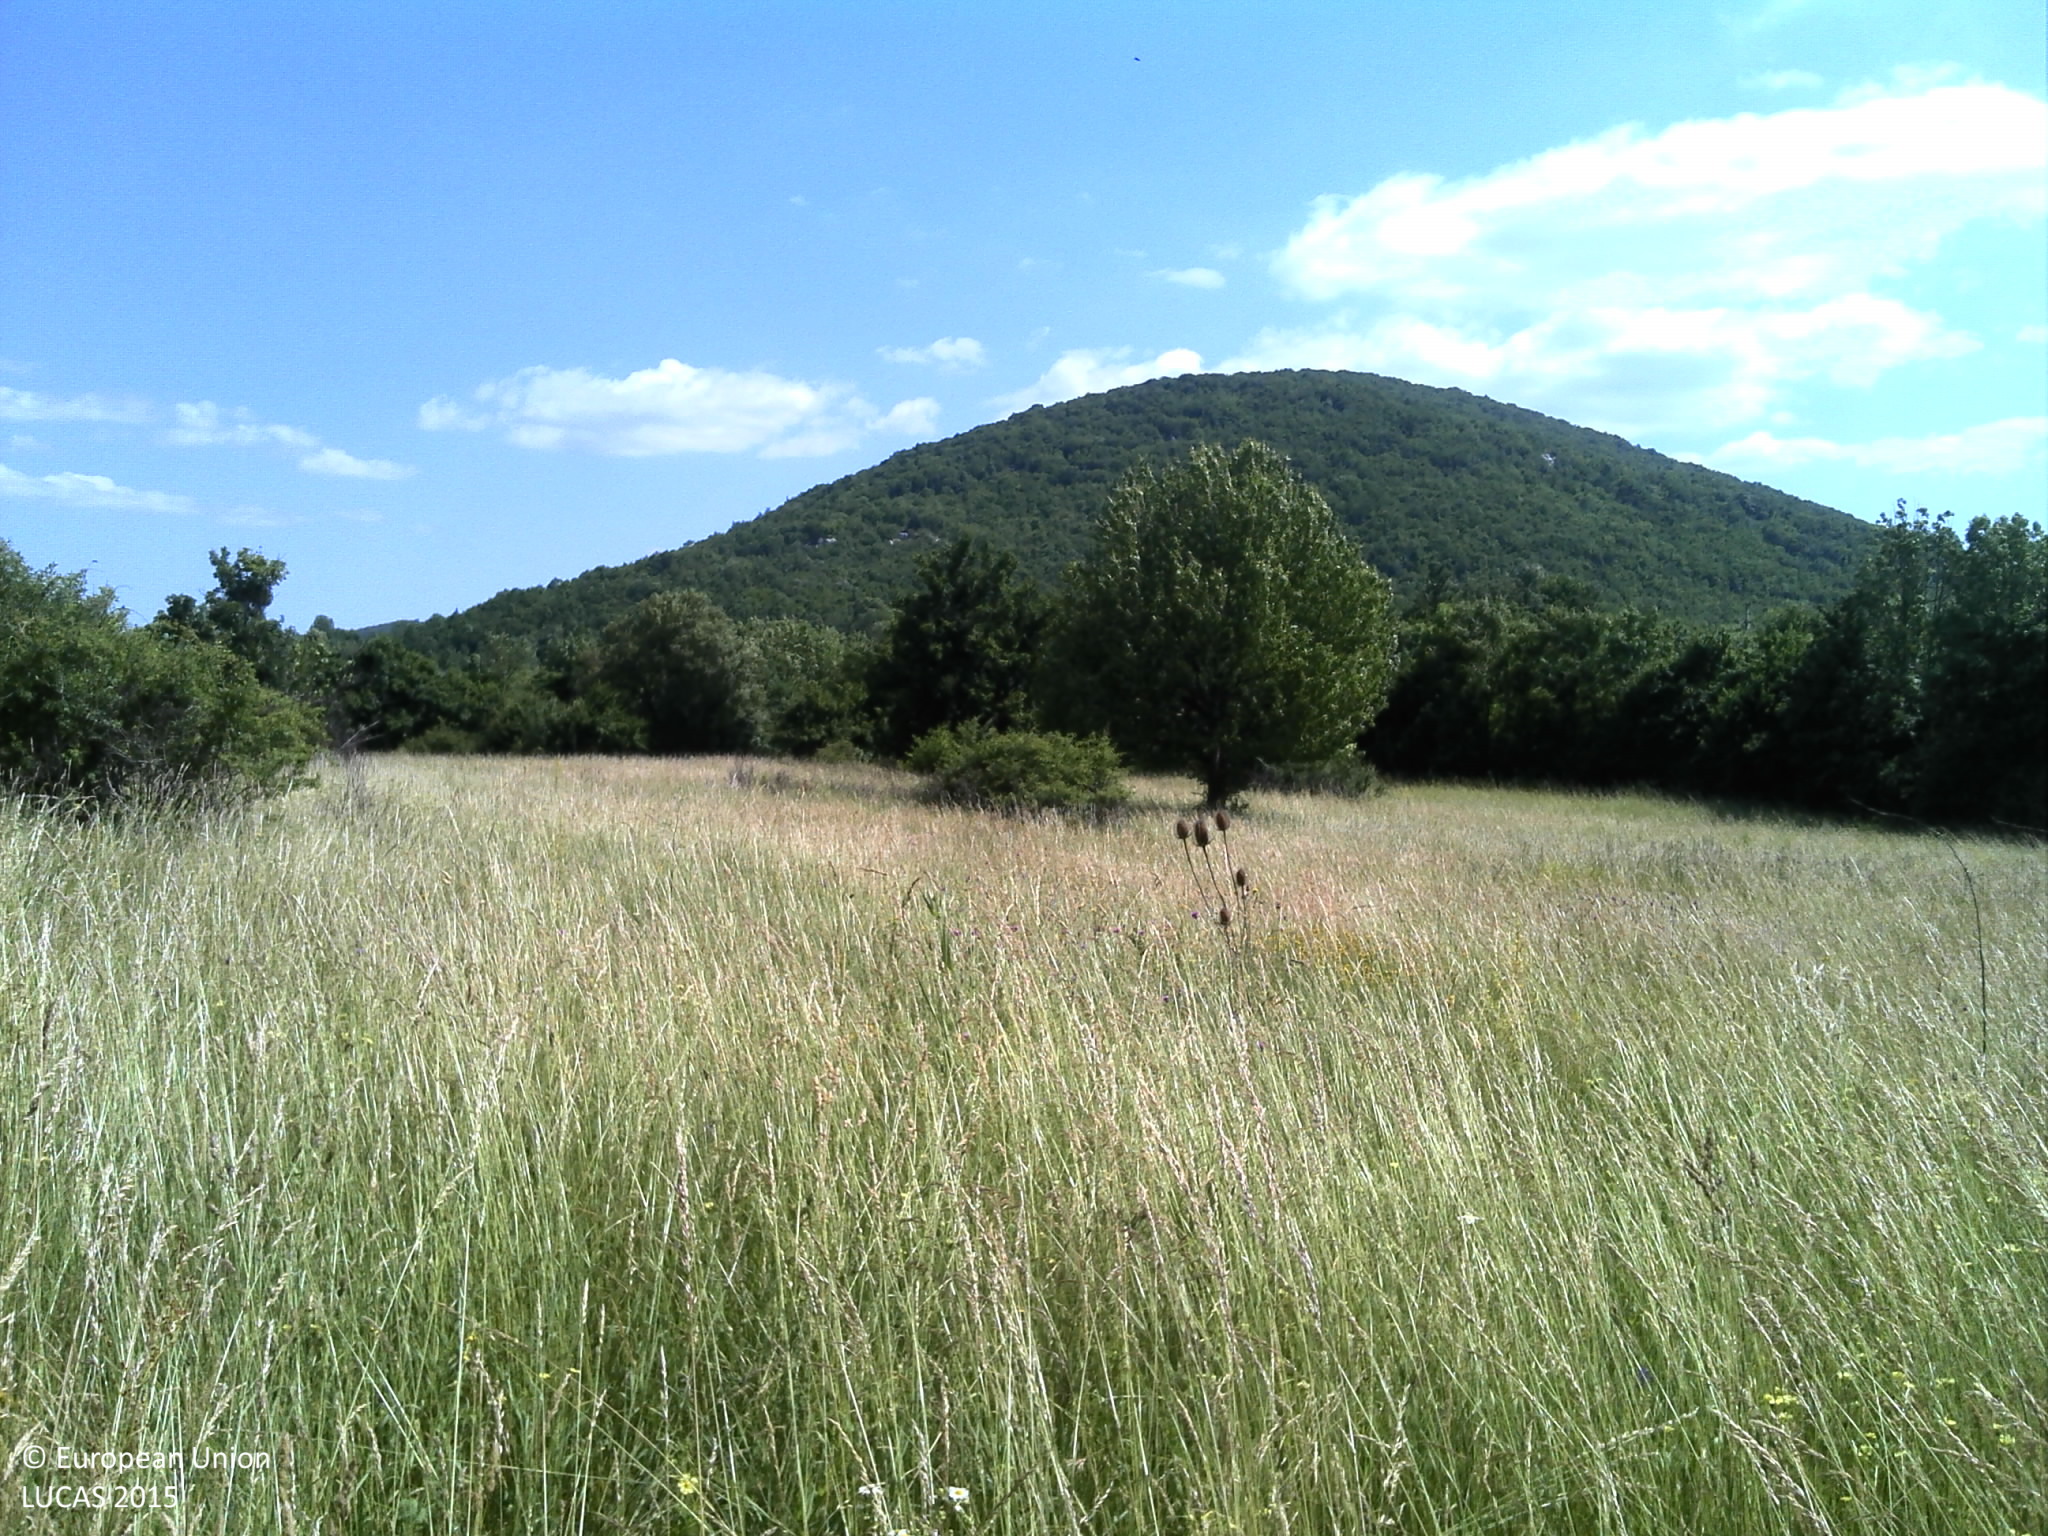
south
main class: Woodland
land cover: Broadleaved woodland
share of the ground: 10 - 25 %
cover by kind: herbaceous plants 80 %, broadleaved forest trees 20 %
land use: Abandoned areas
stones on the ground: < 10 %
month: June
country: HR
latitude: 44.4491
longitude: 15.6606
